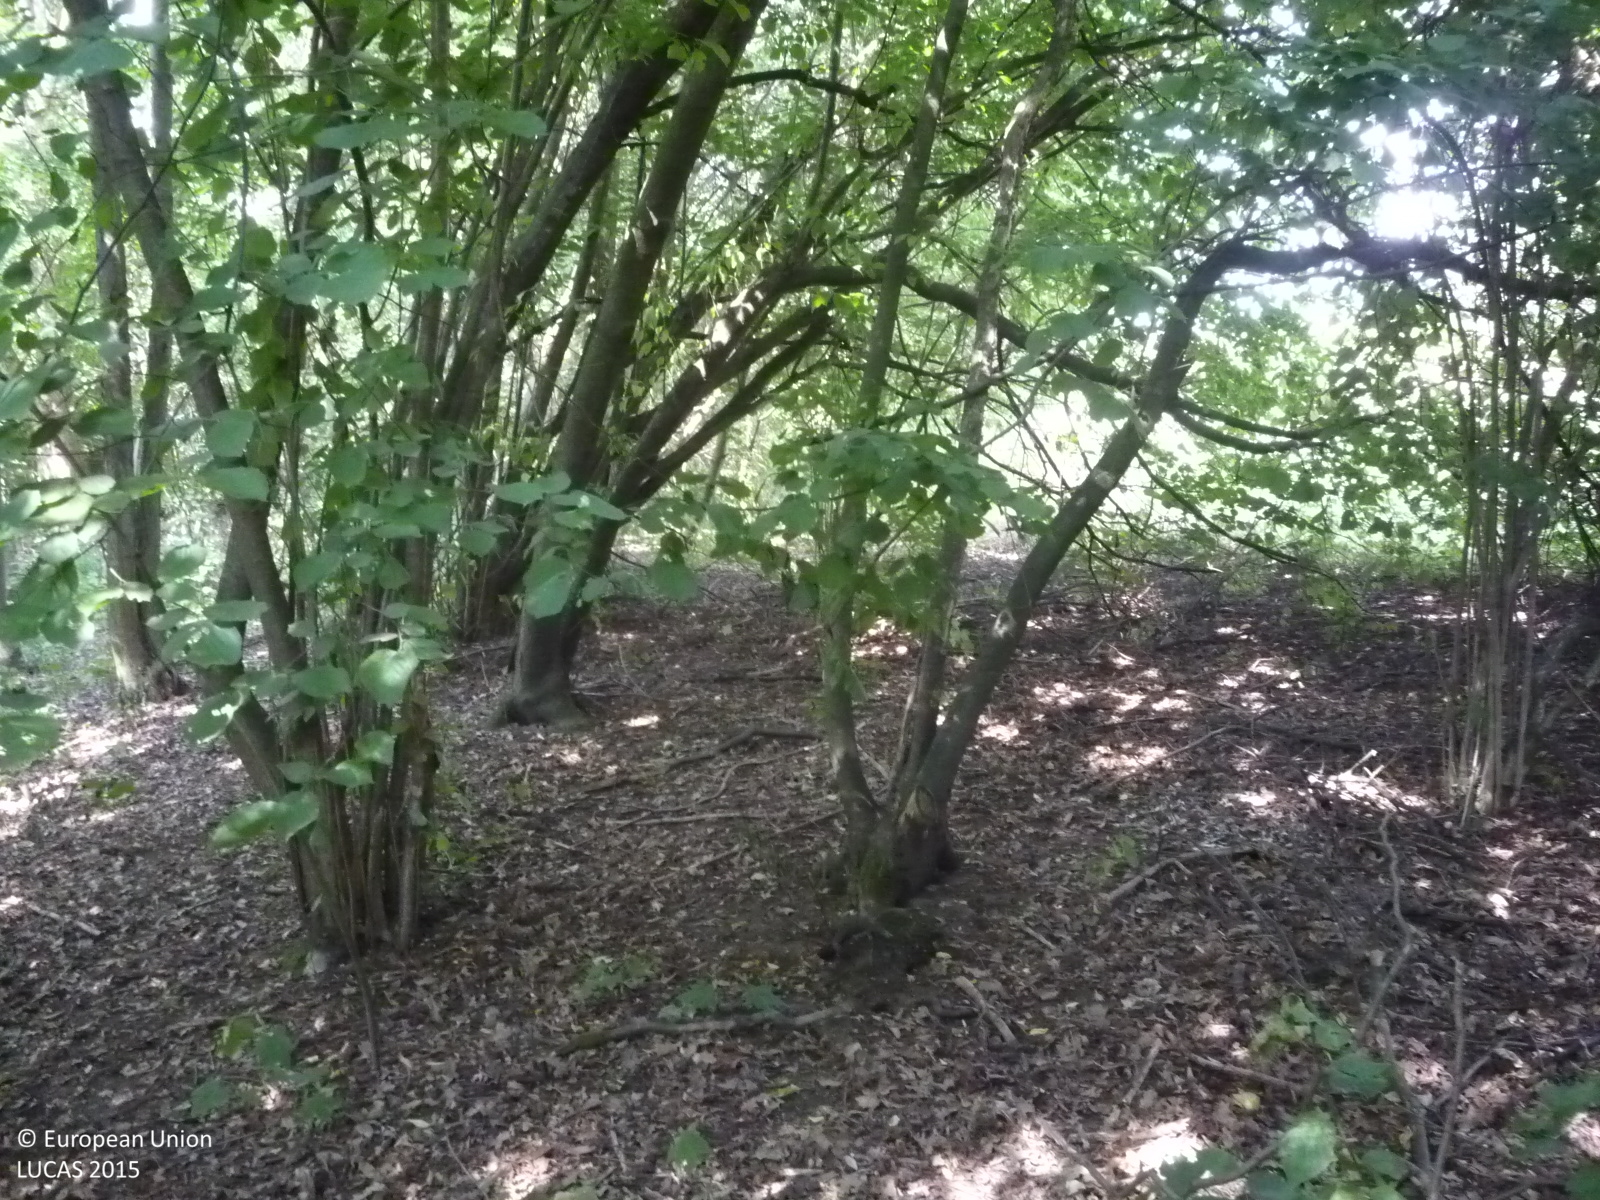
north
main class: Woodland
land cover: Broadleaved woodland
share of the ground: > 75 %
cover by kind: broadleaved forest trees 70 %, shrubs 25 %, unconsolidated bare surface 5 %
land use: Forestry
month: August
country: CZ
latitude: 49.8956
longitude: 14.9724
